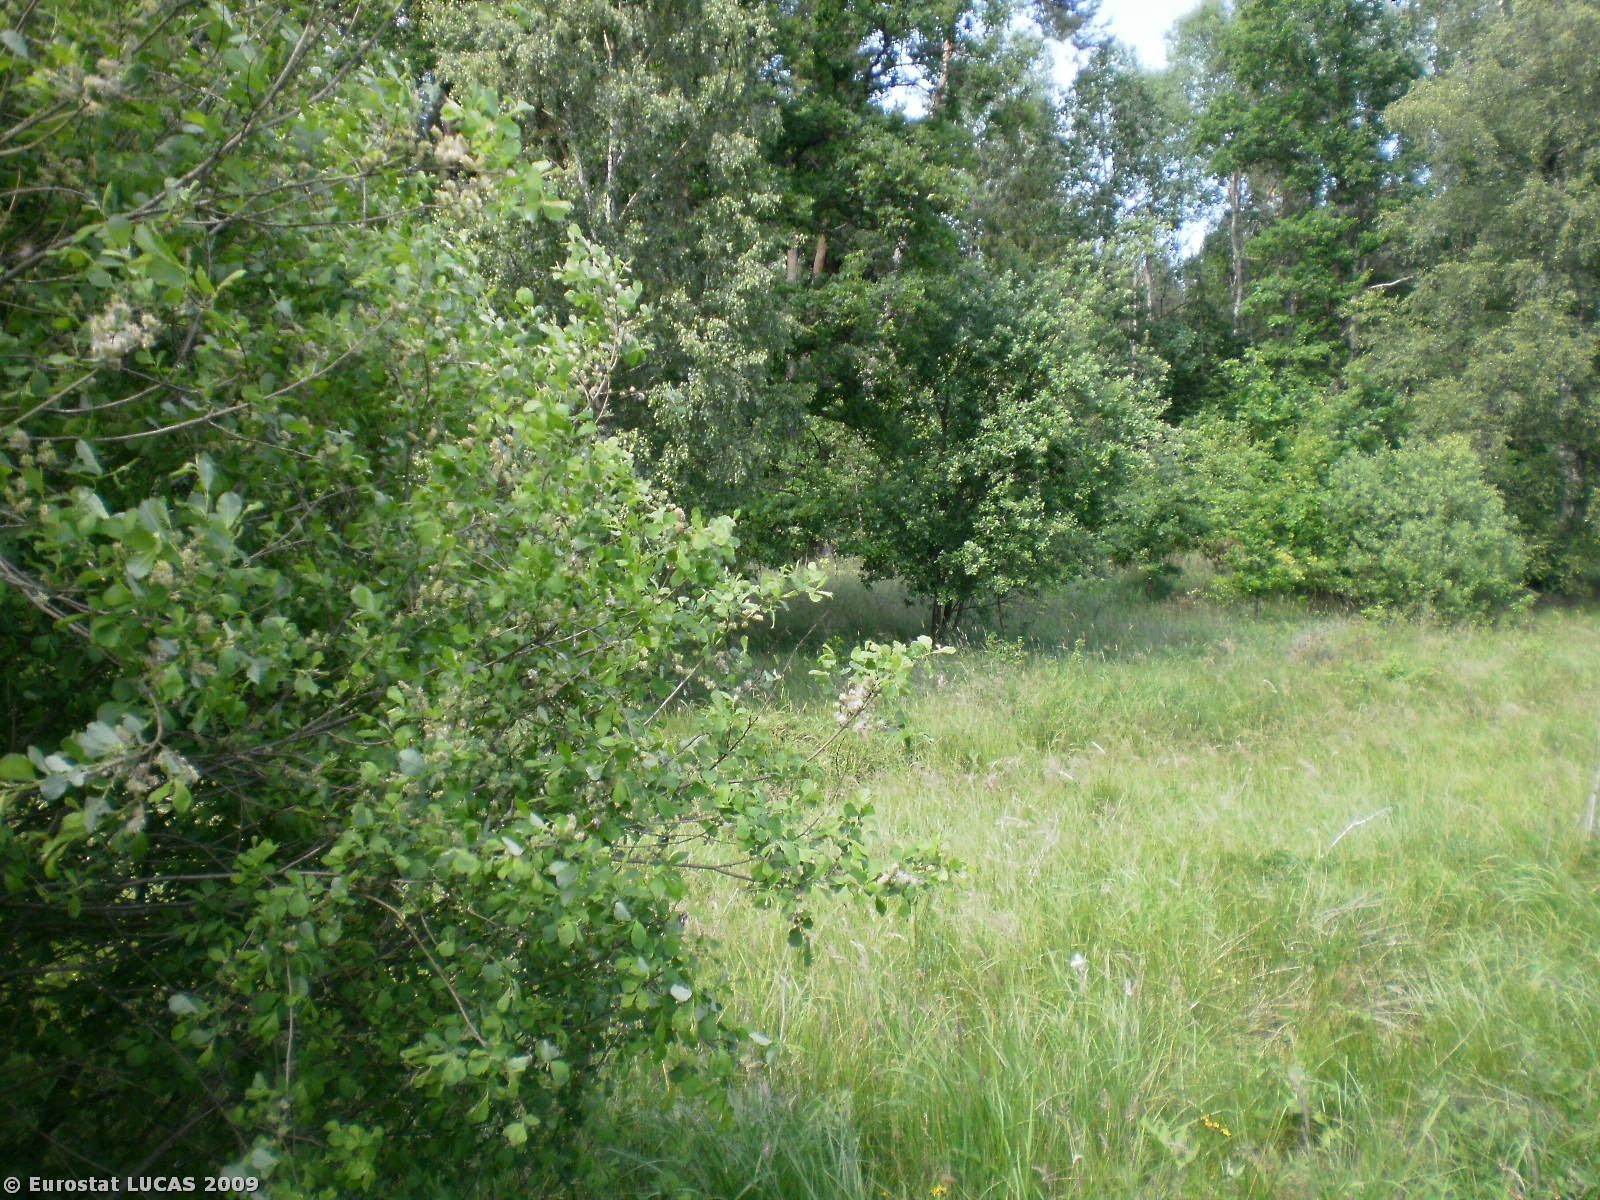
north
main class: Grassland
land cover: Grassland with sparse tree/shrub cover
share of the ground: > 75 %
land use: Agriculture (excluding fallow land and kitchen gardens)
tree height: < 5 m
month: June
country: PL
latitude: 54.3914
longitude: 17.2939
